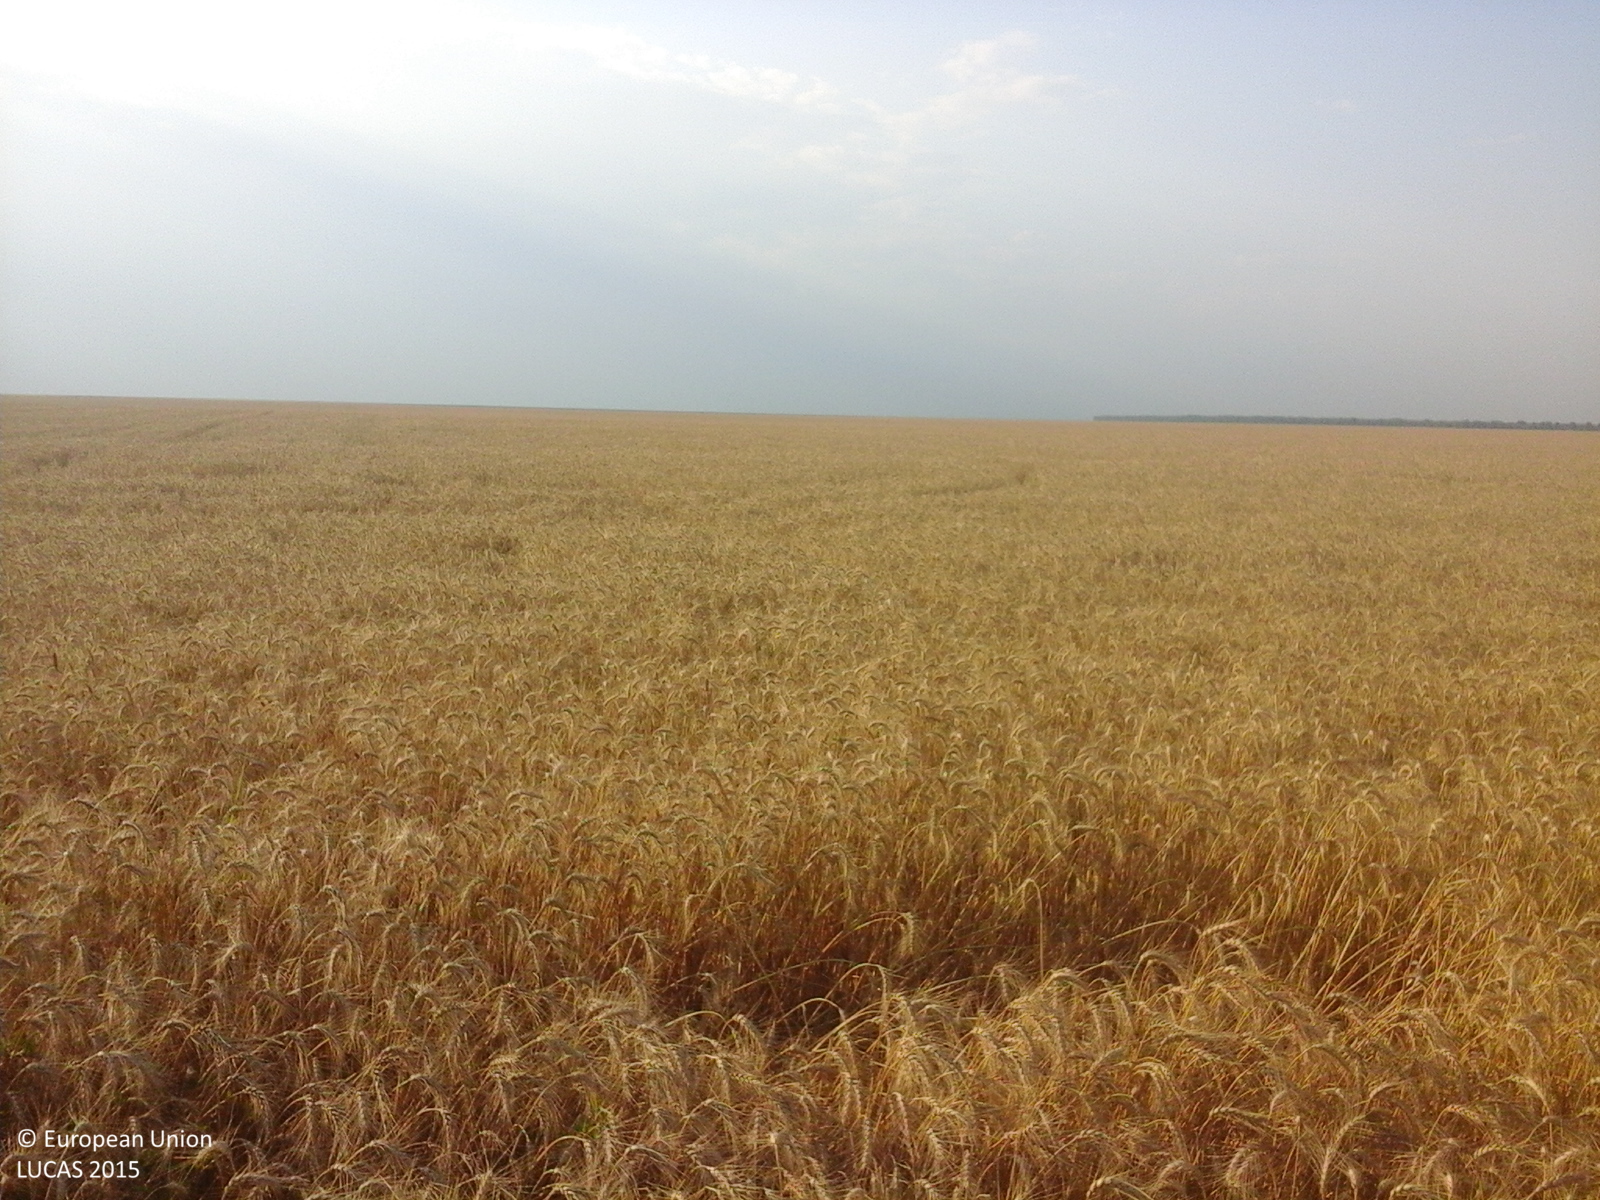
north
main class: Cropland
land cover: Common wheat
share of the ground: > 75 %
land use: Agriculture (excluding fallow land and kitchen gardens)
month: July
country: RO
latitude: 43.9261
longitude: 24.7810
